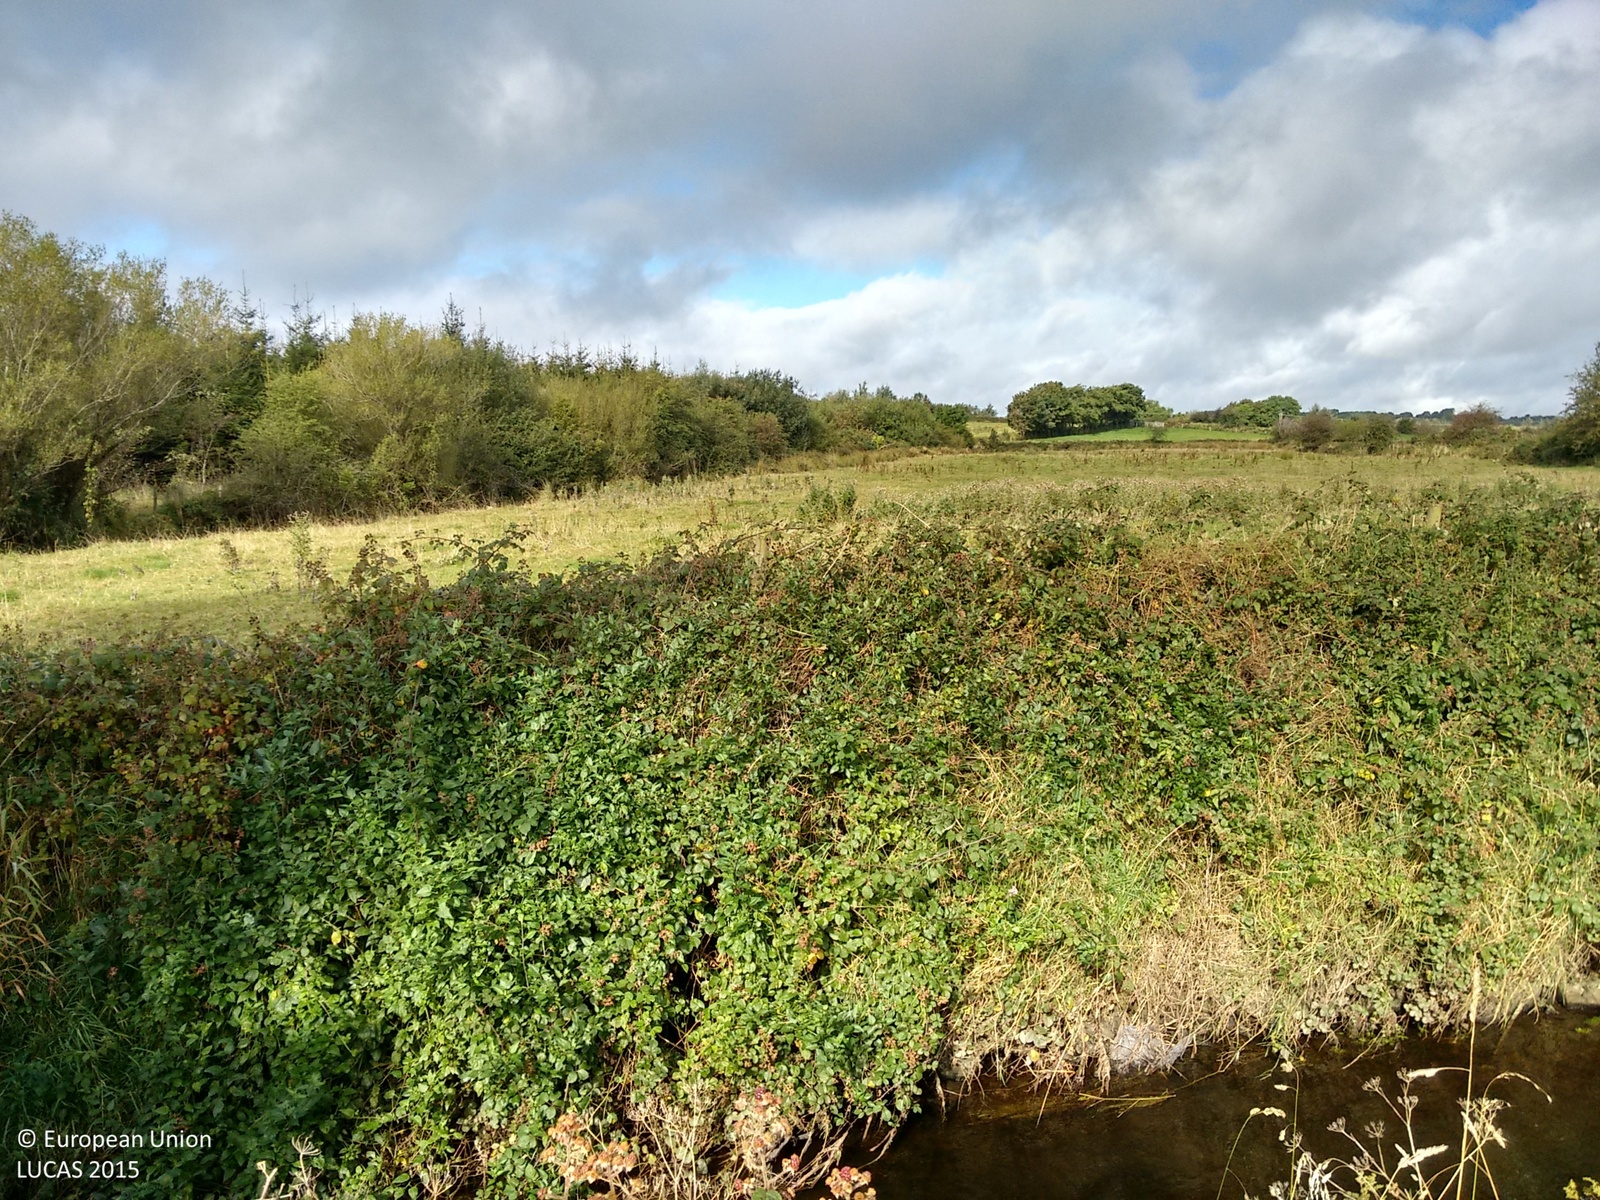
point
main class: Woodland
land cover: Broadleaved woodland
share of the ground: > 75 %
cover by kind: broadleaved forest trees 75 %, herbaceous plants 25 %
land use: Agriculture (excluding fallow land and kitchen gardens)
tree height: < 5 m
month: September
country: IE
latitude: 53.7443
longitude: -8.7778
